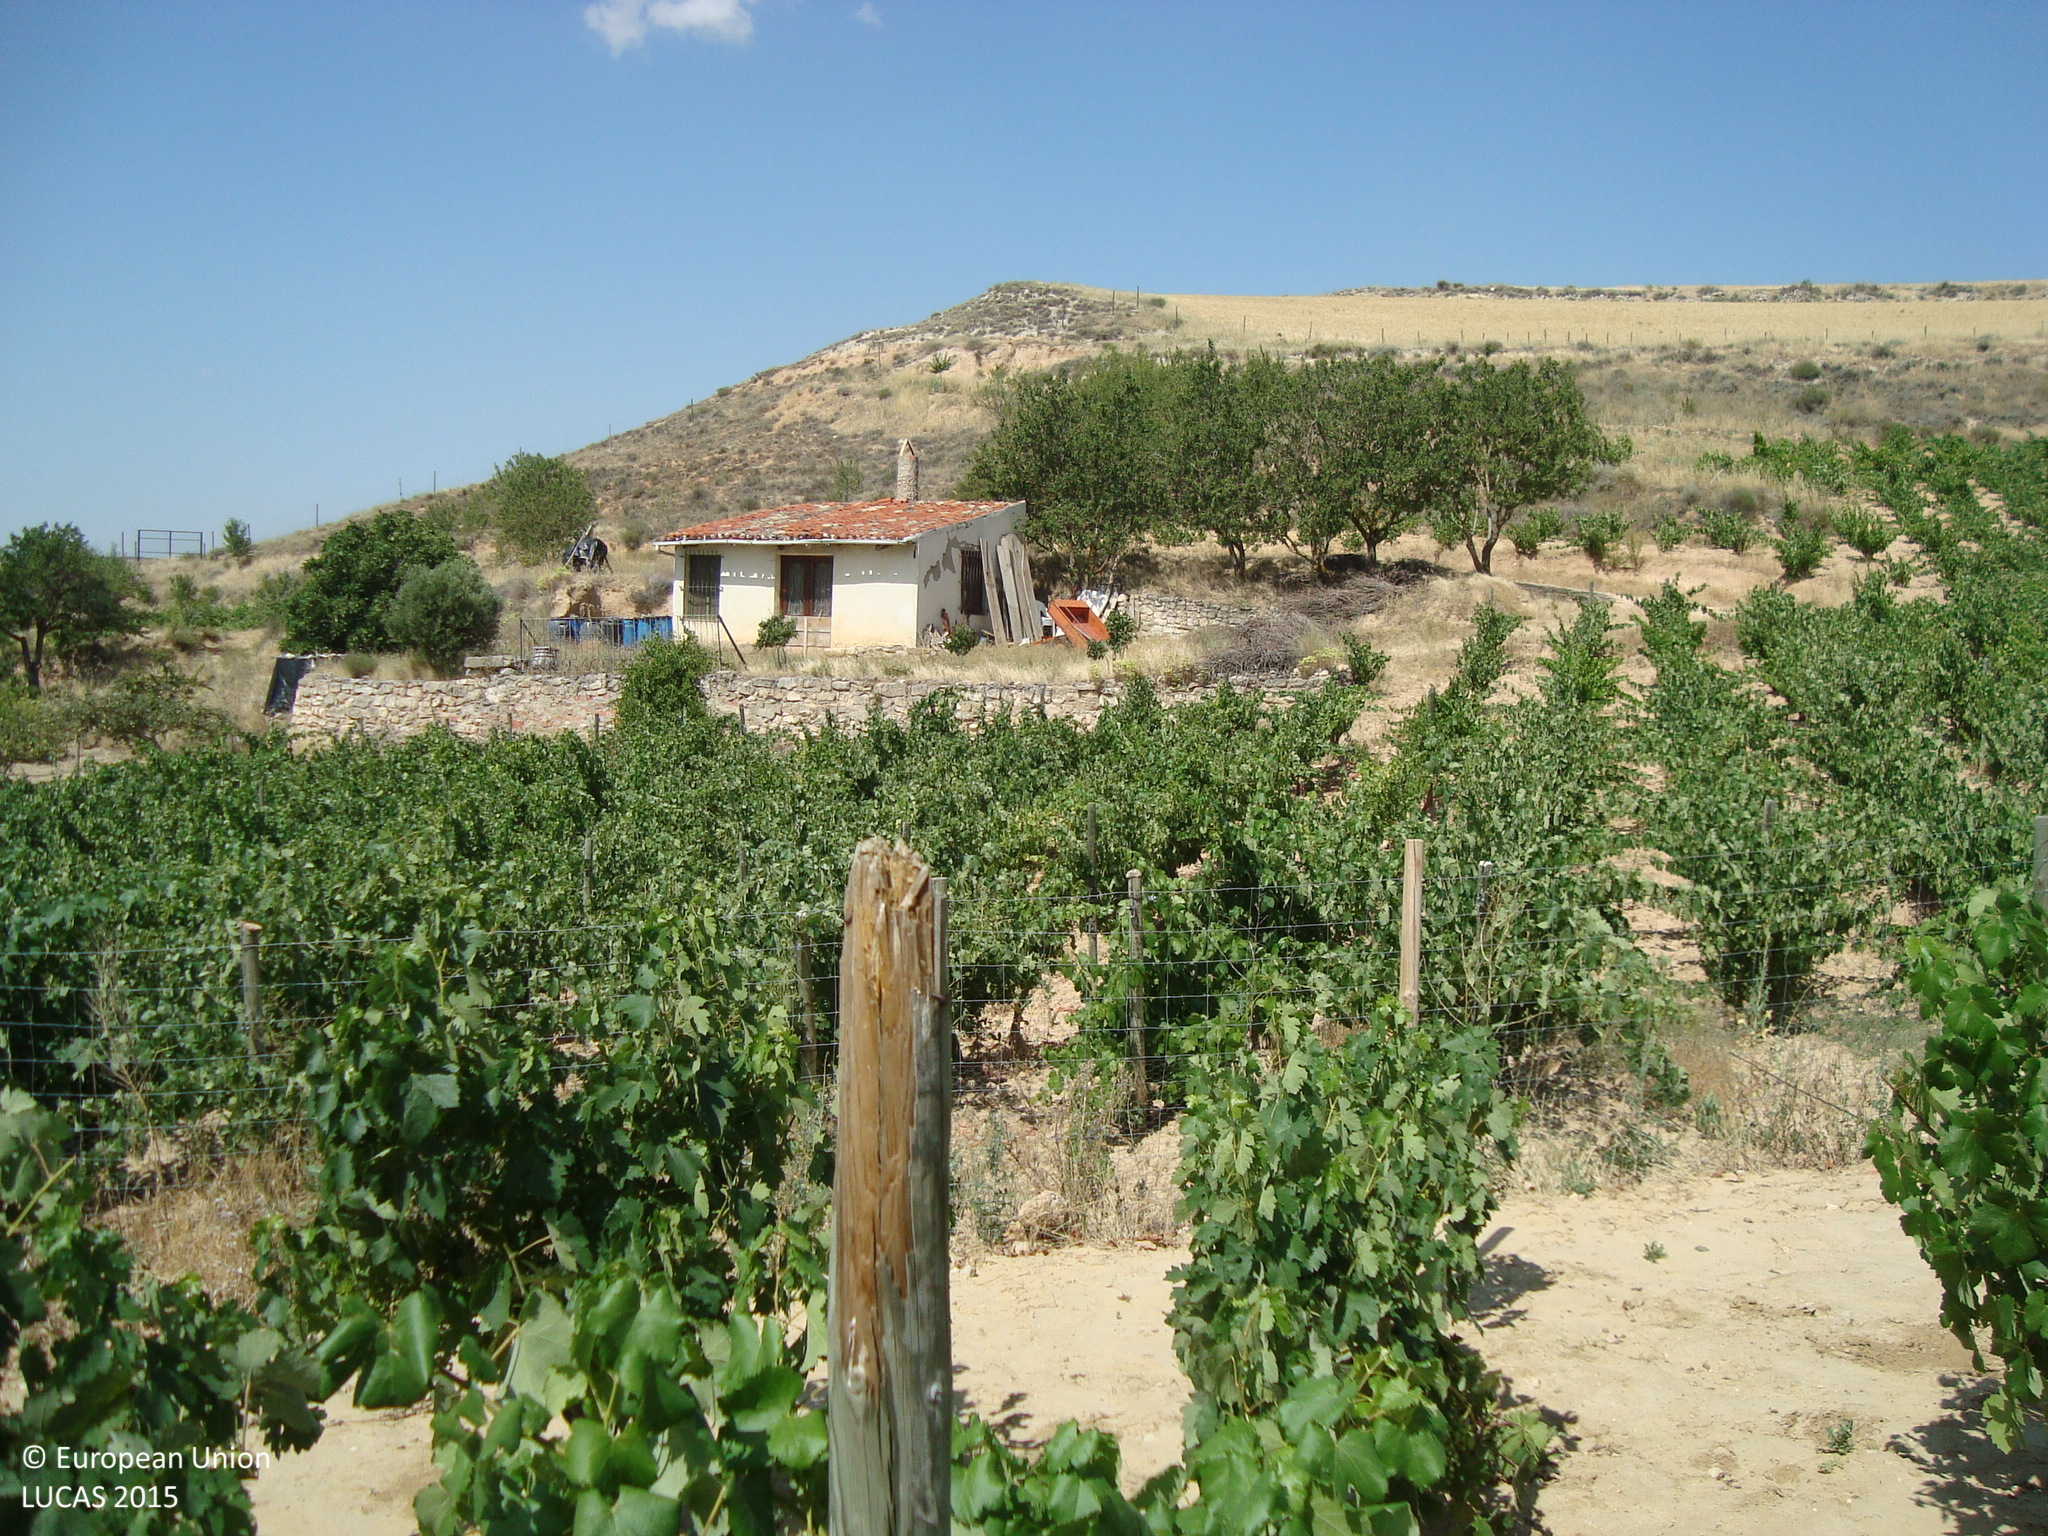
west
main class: Grassland
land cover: Grassland with sparse tree/shrub cover
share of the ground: > 75 %
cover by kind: herbaceous plants 50 %, unconsolidated bare surface 35 %, shrubs 10 %, broadleaved forest trees 5 %
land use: Abandoned areas
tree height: < 5 m
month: July
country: ES
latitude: 41.9534
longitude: -4.2398
